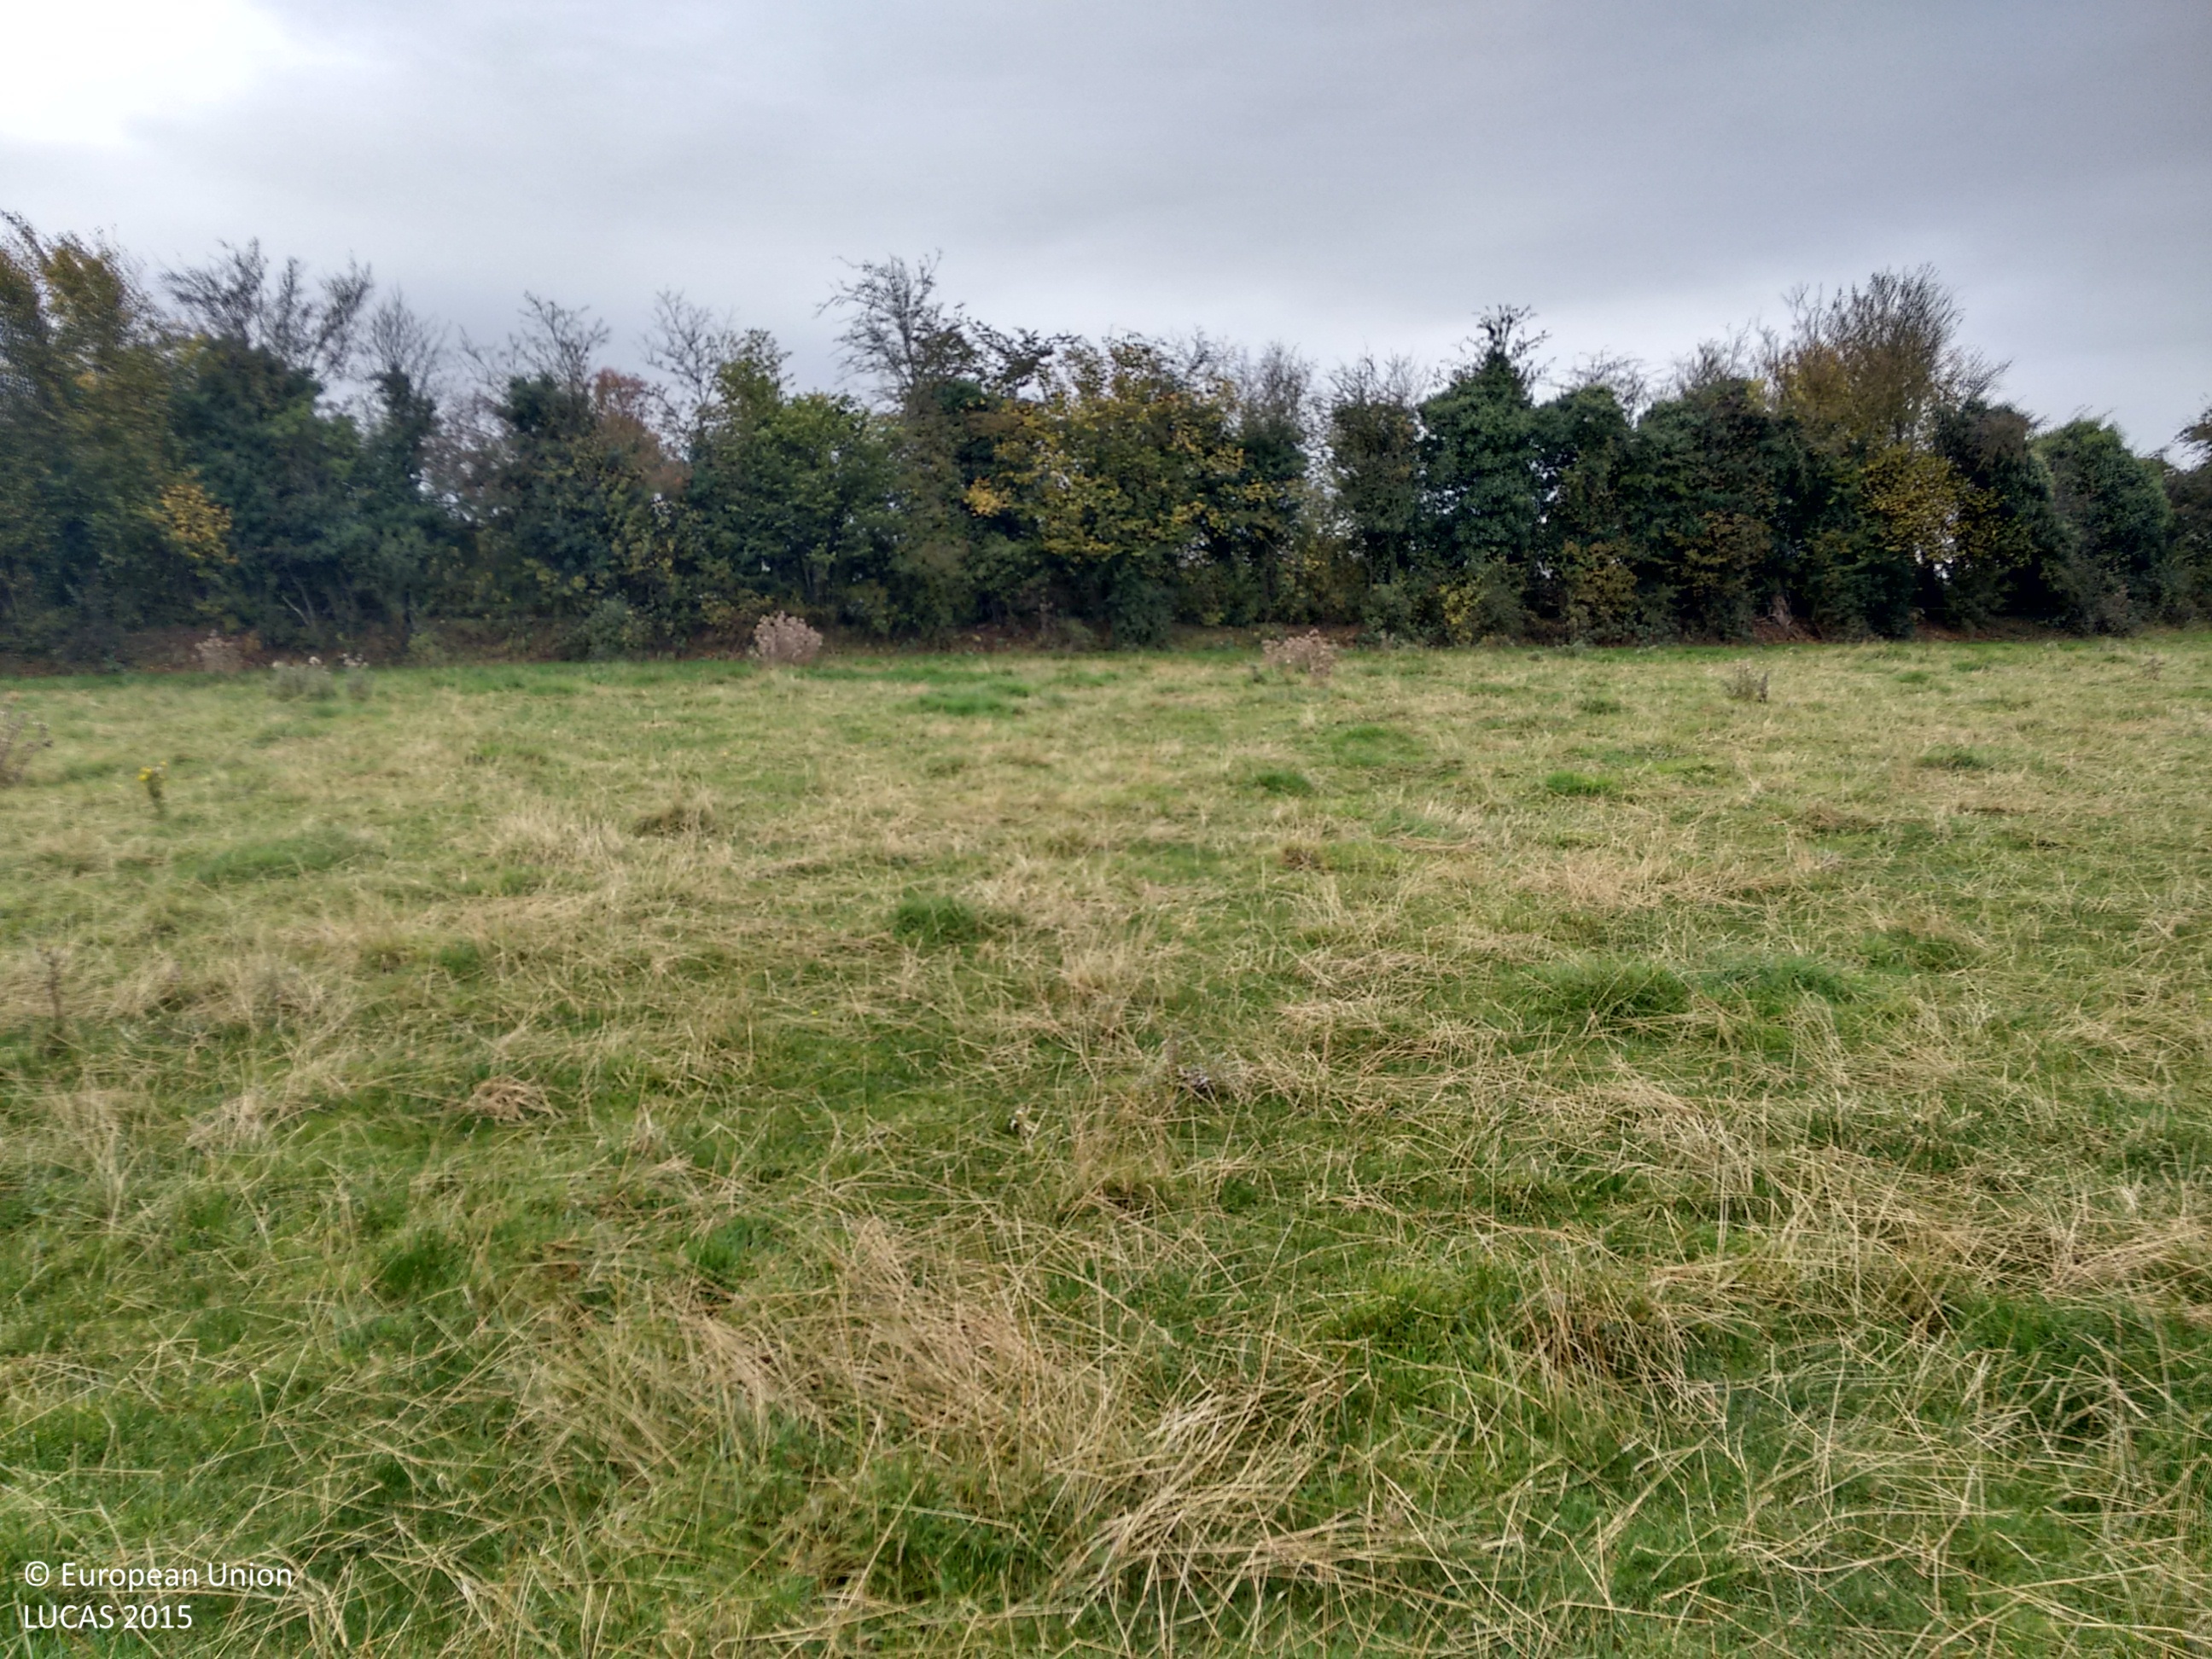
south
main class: Grassland
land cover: Grassland without tree/shrub cover
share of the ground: > 75 %
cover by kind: herbaceous plants 100 %
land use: Agriculture (excluding fallow land and kitchen gardens)
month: October
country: IE
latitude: 53.0815
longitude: -7.7995
